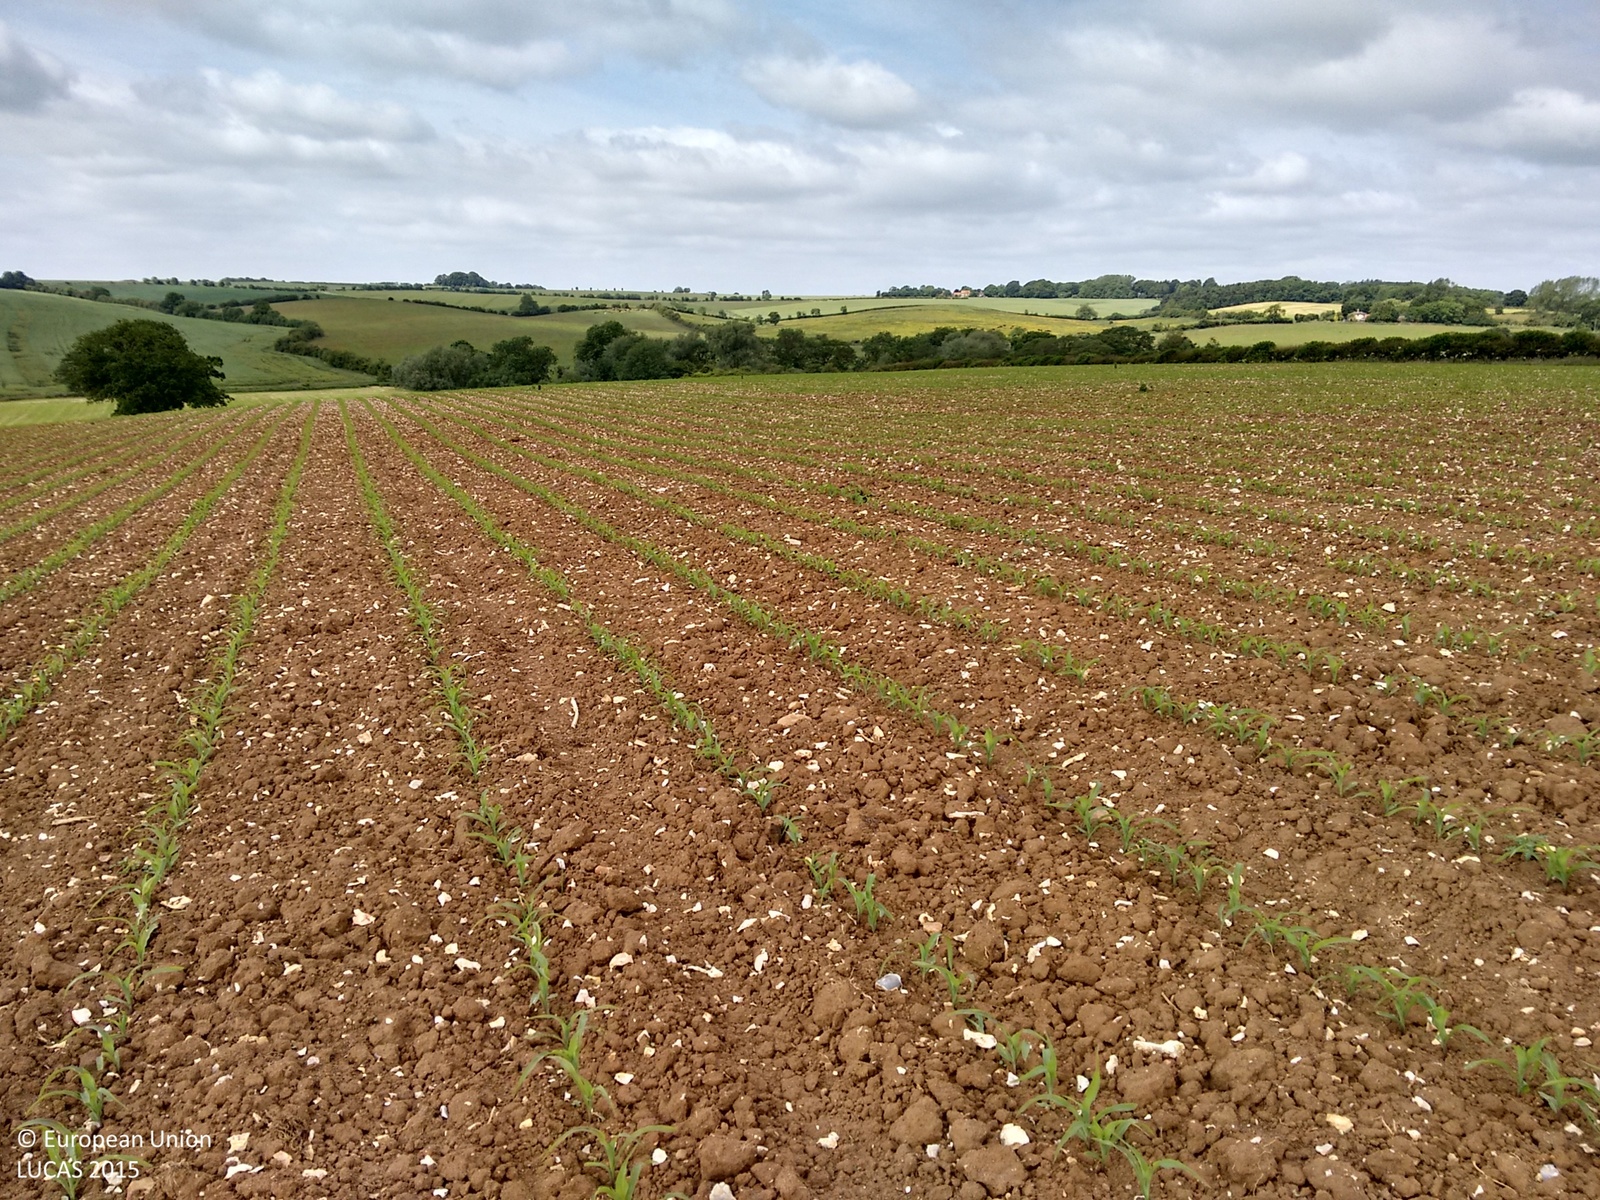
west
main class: Cropland
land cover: Maize
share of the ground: < 10 %
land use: Agriculture (excluding fallow land and kitchen gardens)
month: June
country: GB
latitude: 53.3021
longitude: -0.1321
